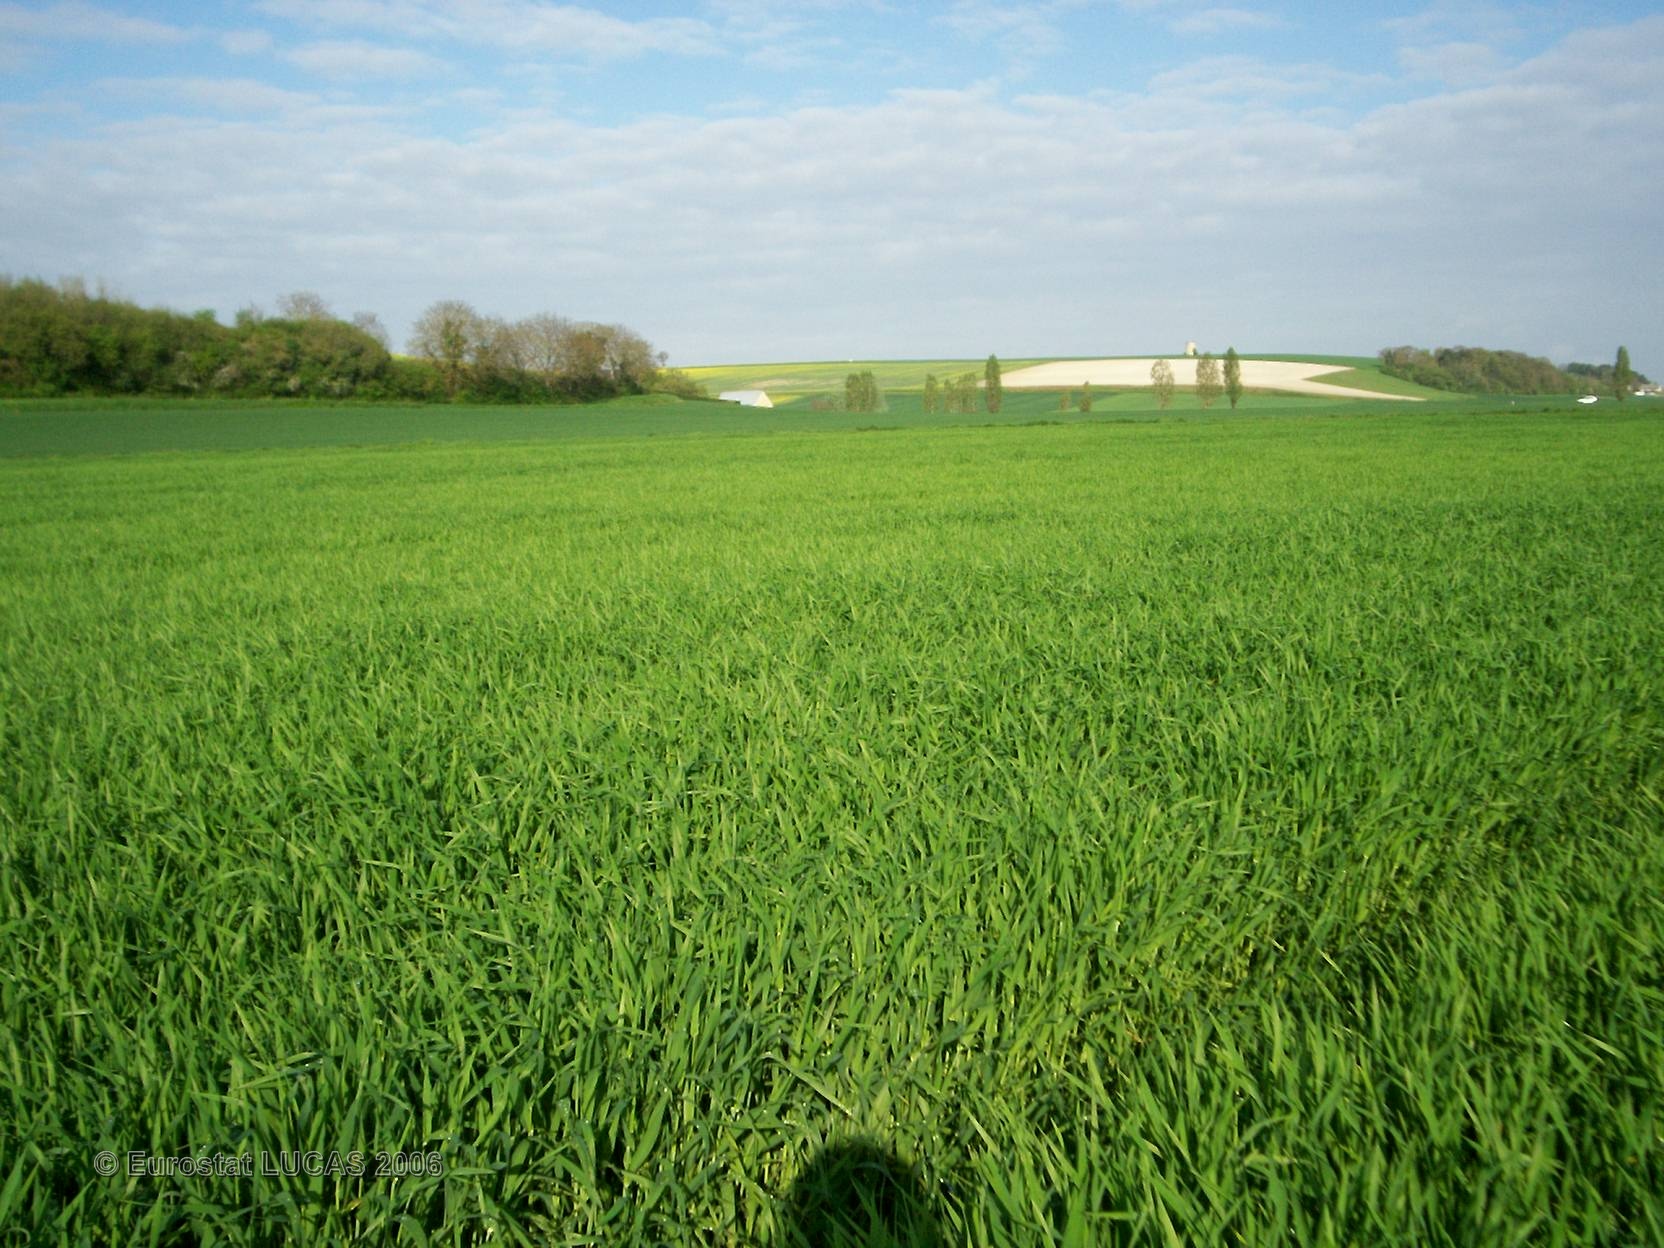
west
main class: Cropland
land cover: Barley
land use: Agriculture (excluding fallow land and kitchen gardens)
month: April
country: FR
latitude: 47.1016
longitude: 0.4534
